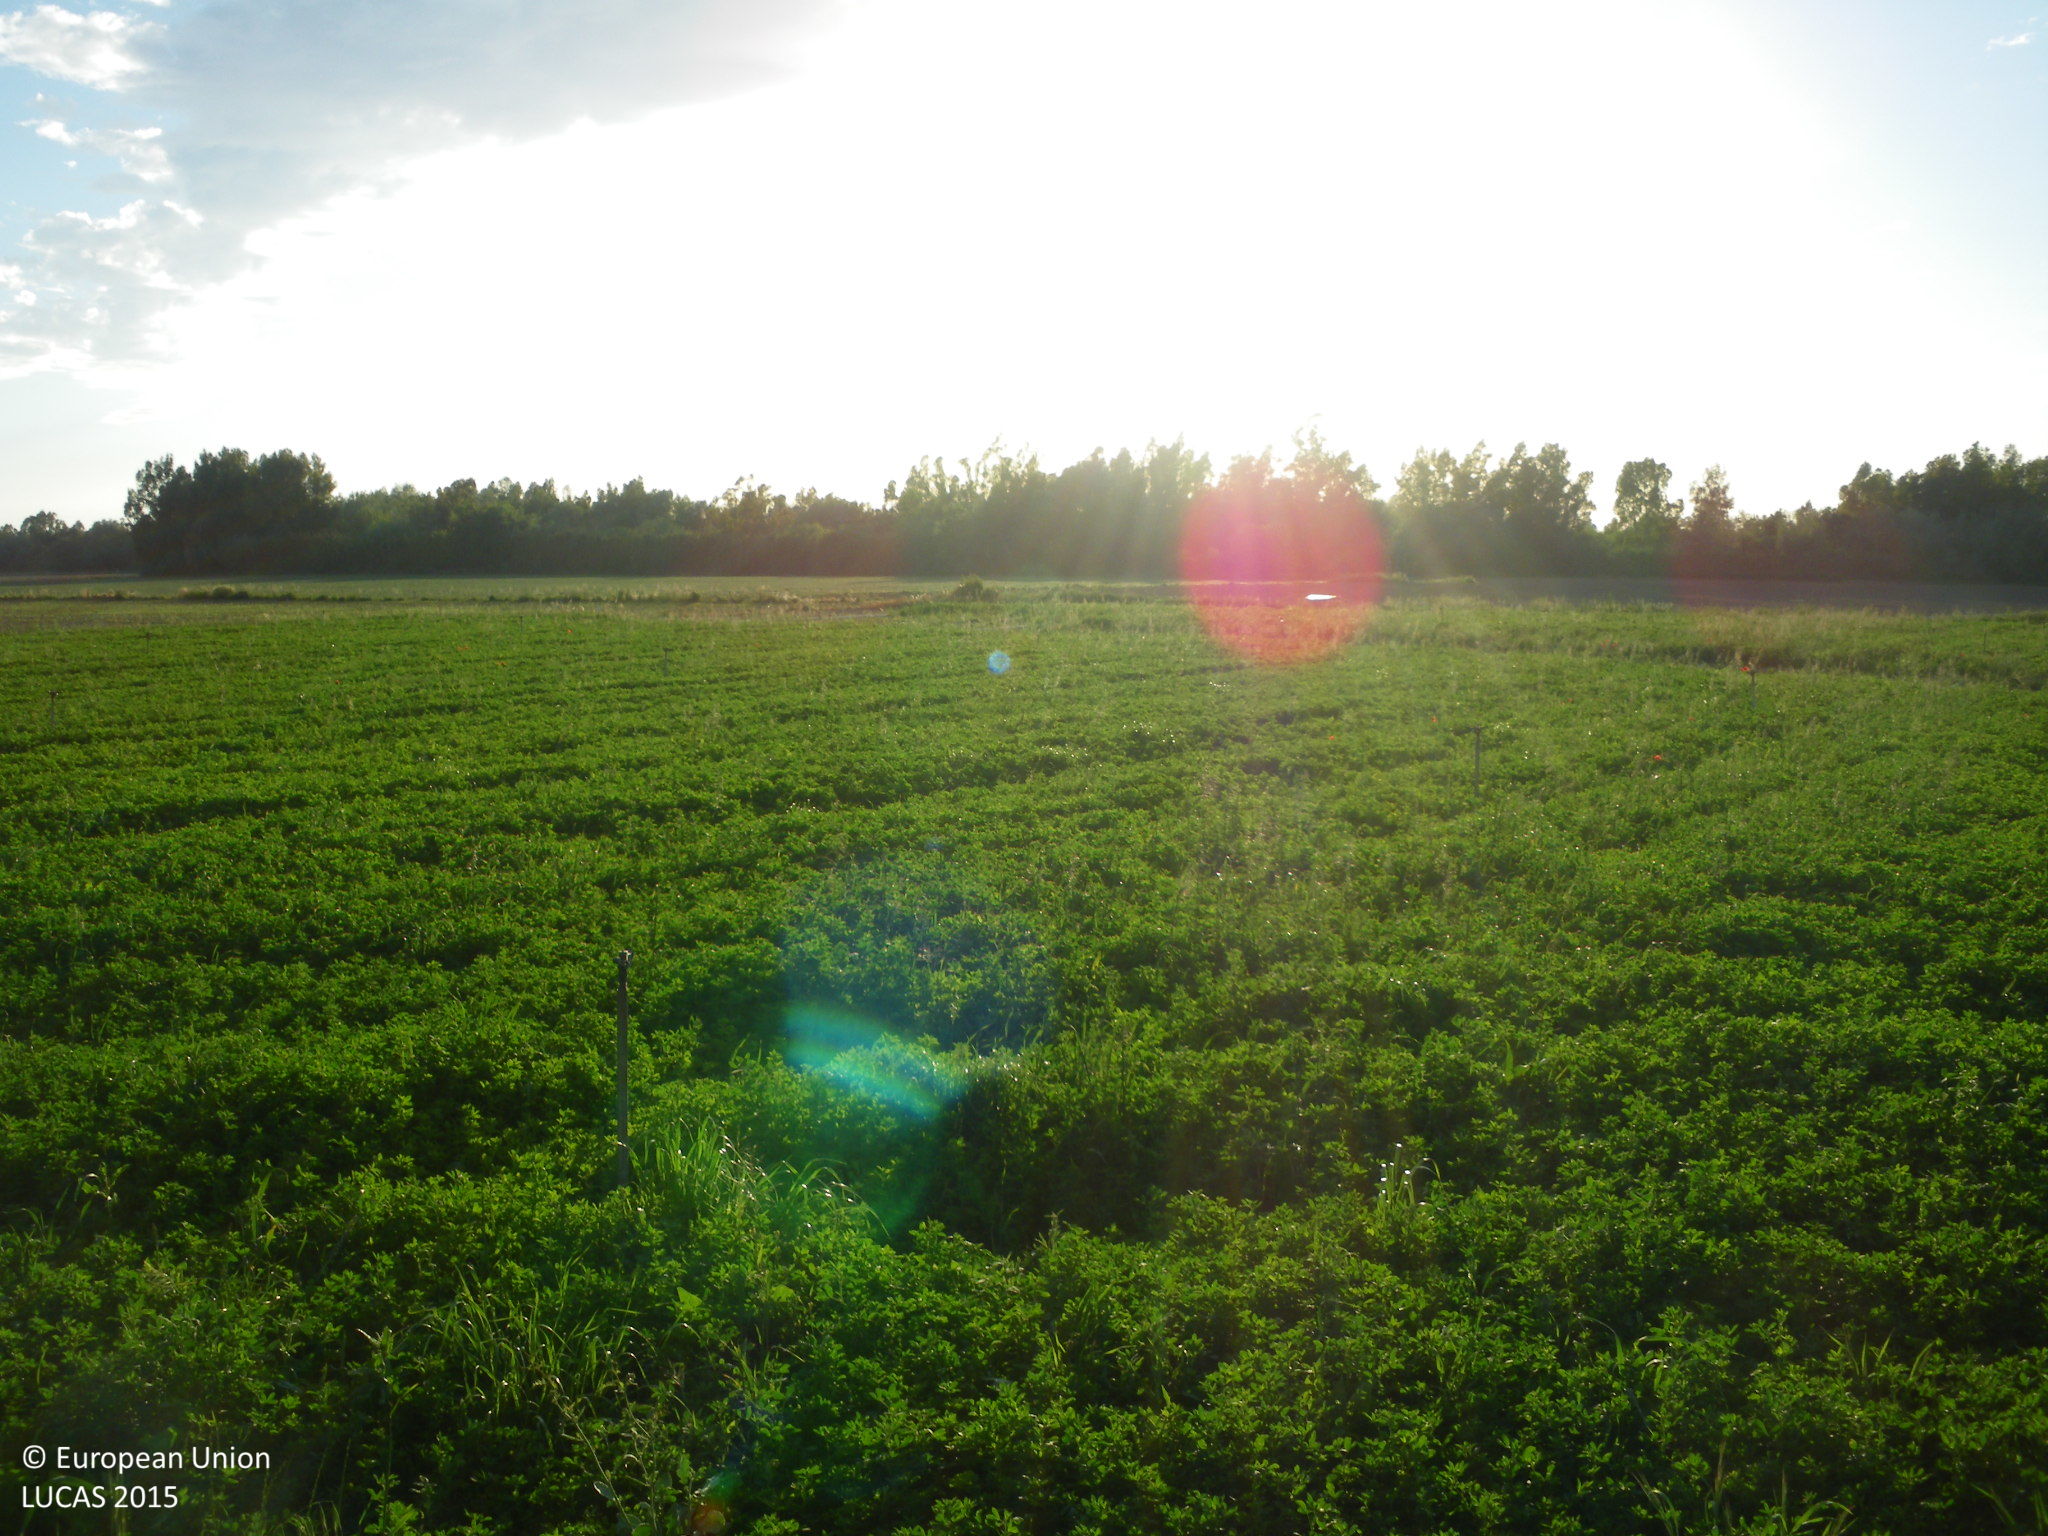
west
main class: Shrubland
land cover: Shrubland with sparse tree cover
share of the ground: > 75 %
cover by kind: shrubs 75 %, herbaceous plants 20 %, broadleaved forest trees 5 %
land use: Semi-natural and natural areas not in use
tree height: > 5 m
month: April
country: ES
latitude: 36.6363
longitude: -5.9227
